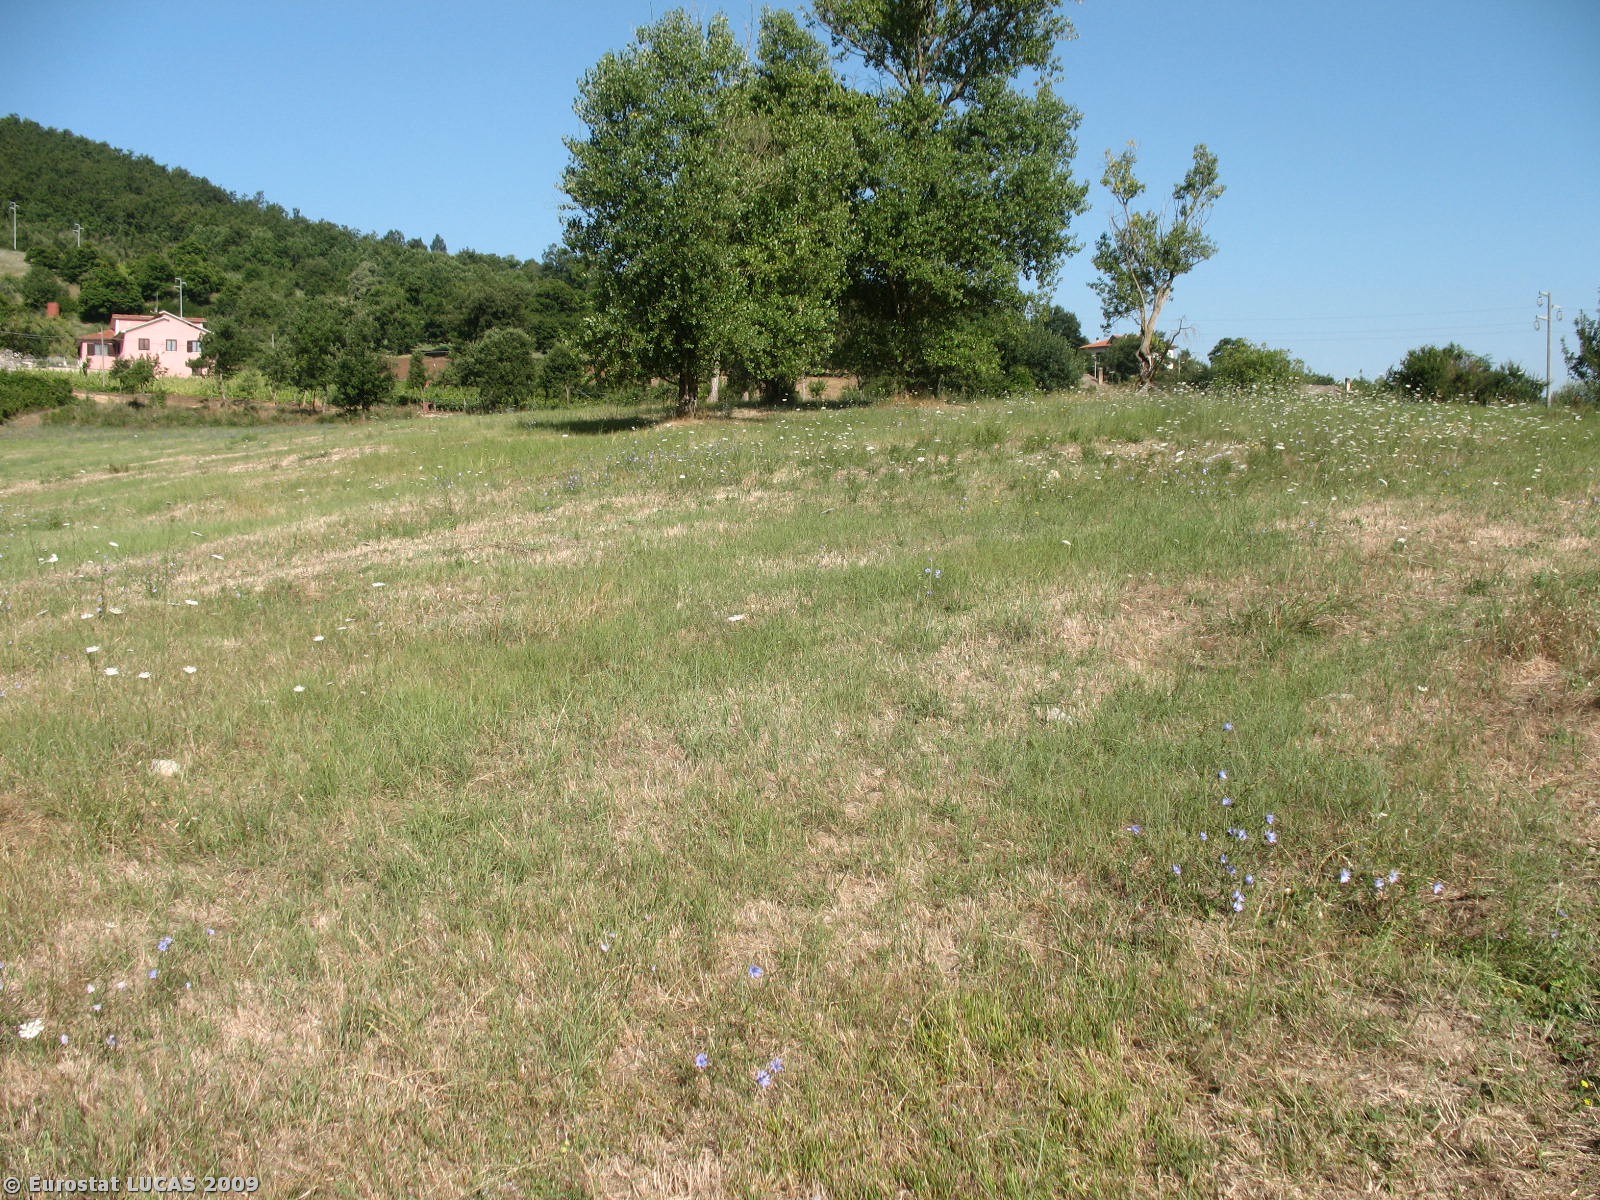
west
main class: Cropland
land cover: Temporary grasslands
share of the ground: < 10 %
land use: Agriculture (excluding fallow land and kitchen gardens)
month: July
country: IT
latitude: 40.8950
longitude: 15.1197
